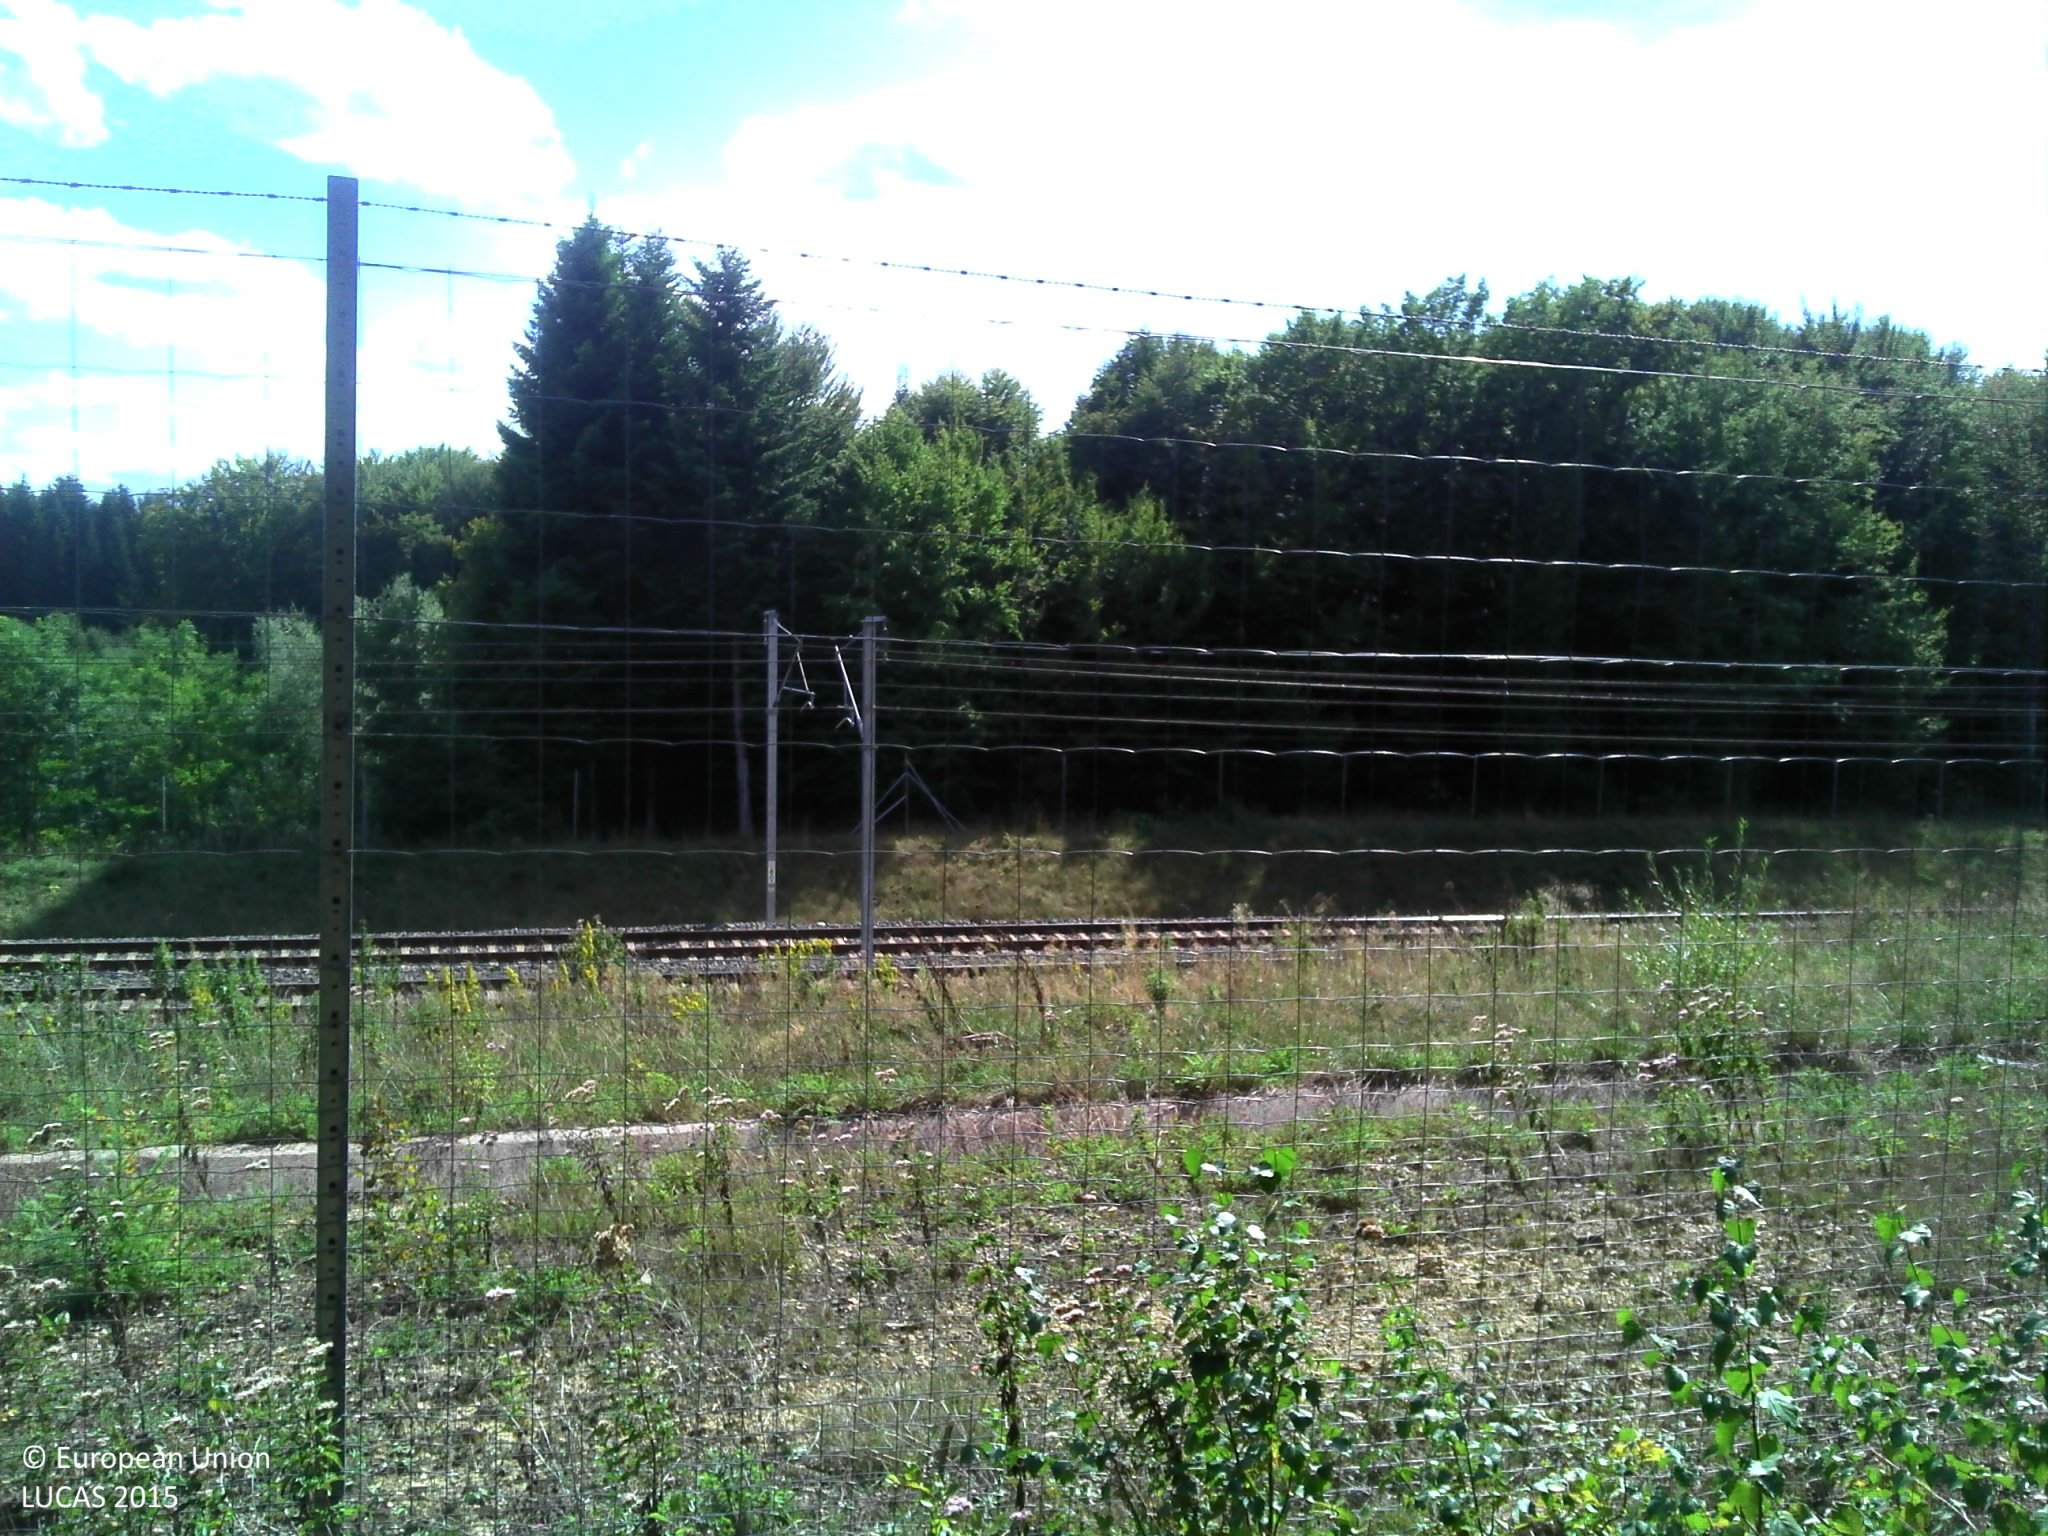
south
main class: Shrubland
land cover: Shrubland with sparse tree cover
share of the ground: > 75 %
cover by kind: herbaceous plants 60 %, shrubs 20 %, unconsolidated bare surface 15 %, broadleaved forest trees 5 %
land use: Semi-natural and natural areas not in use
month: September
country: FR
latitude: 47.4966
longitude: 6.3511
